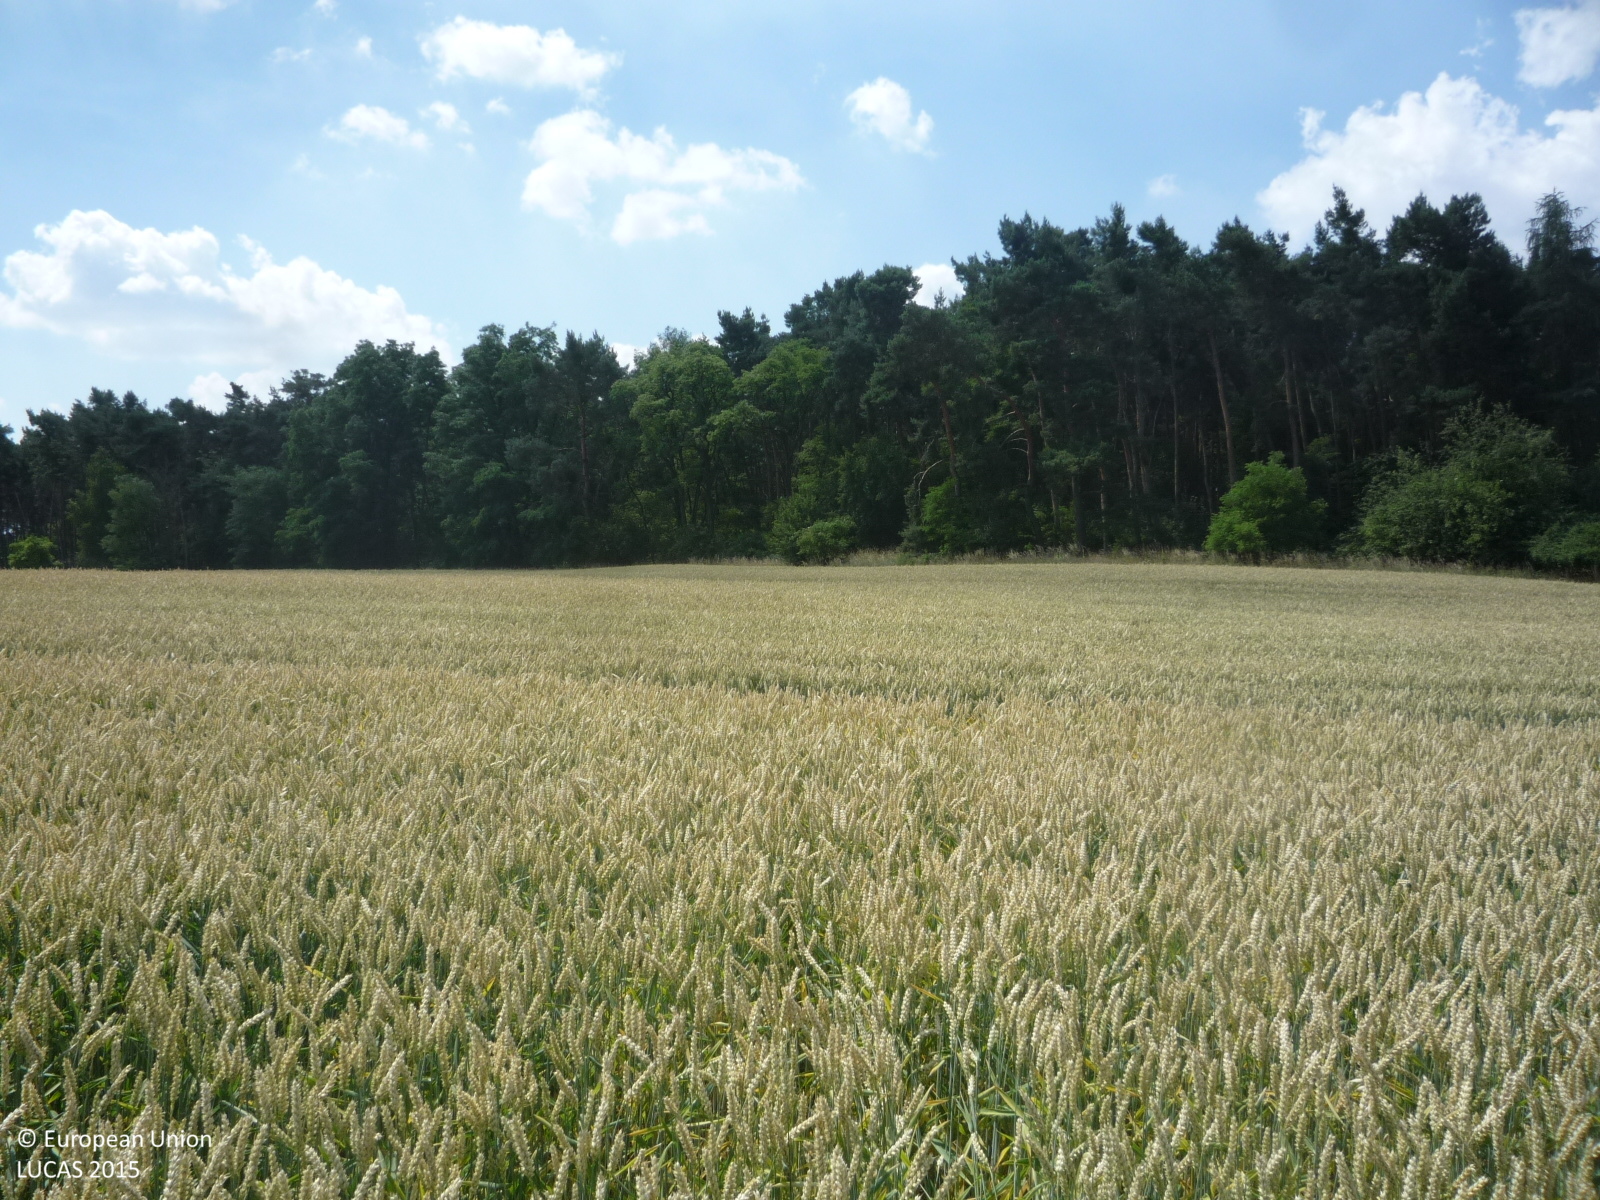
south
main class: Cropland
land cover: Common wheat
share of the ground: > 75 %
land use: Agriculture (excluding fallow land and kitchen gardens)
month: July
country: CZ
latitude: 50.0458
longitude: 15.2400
